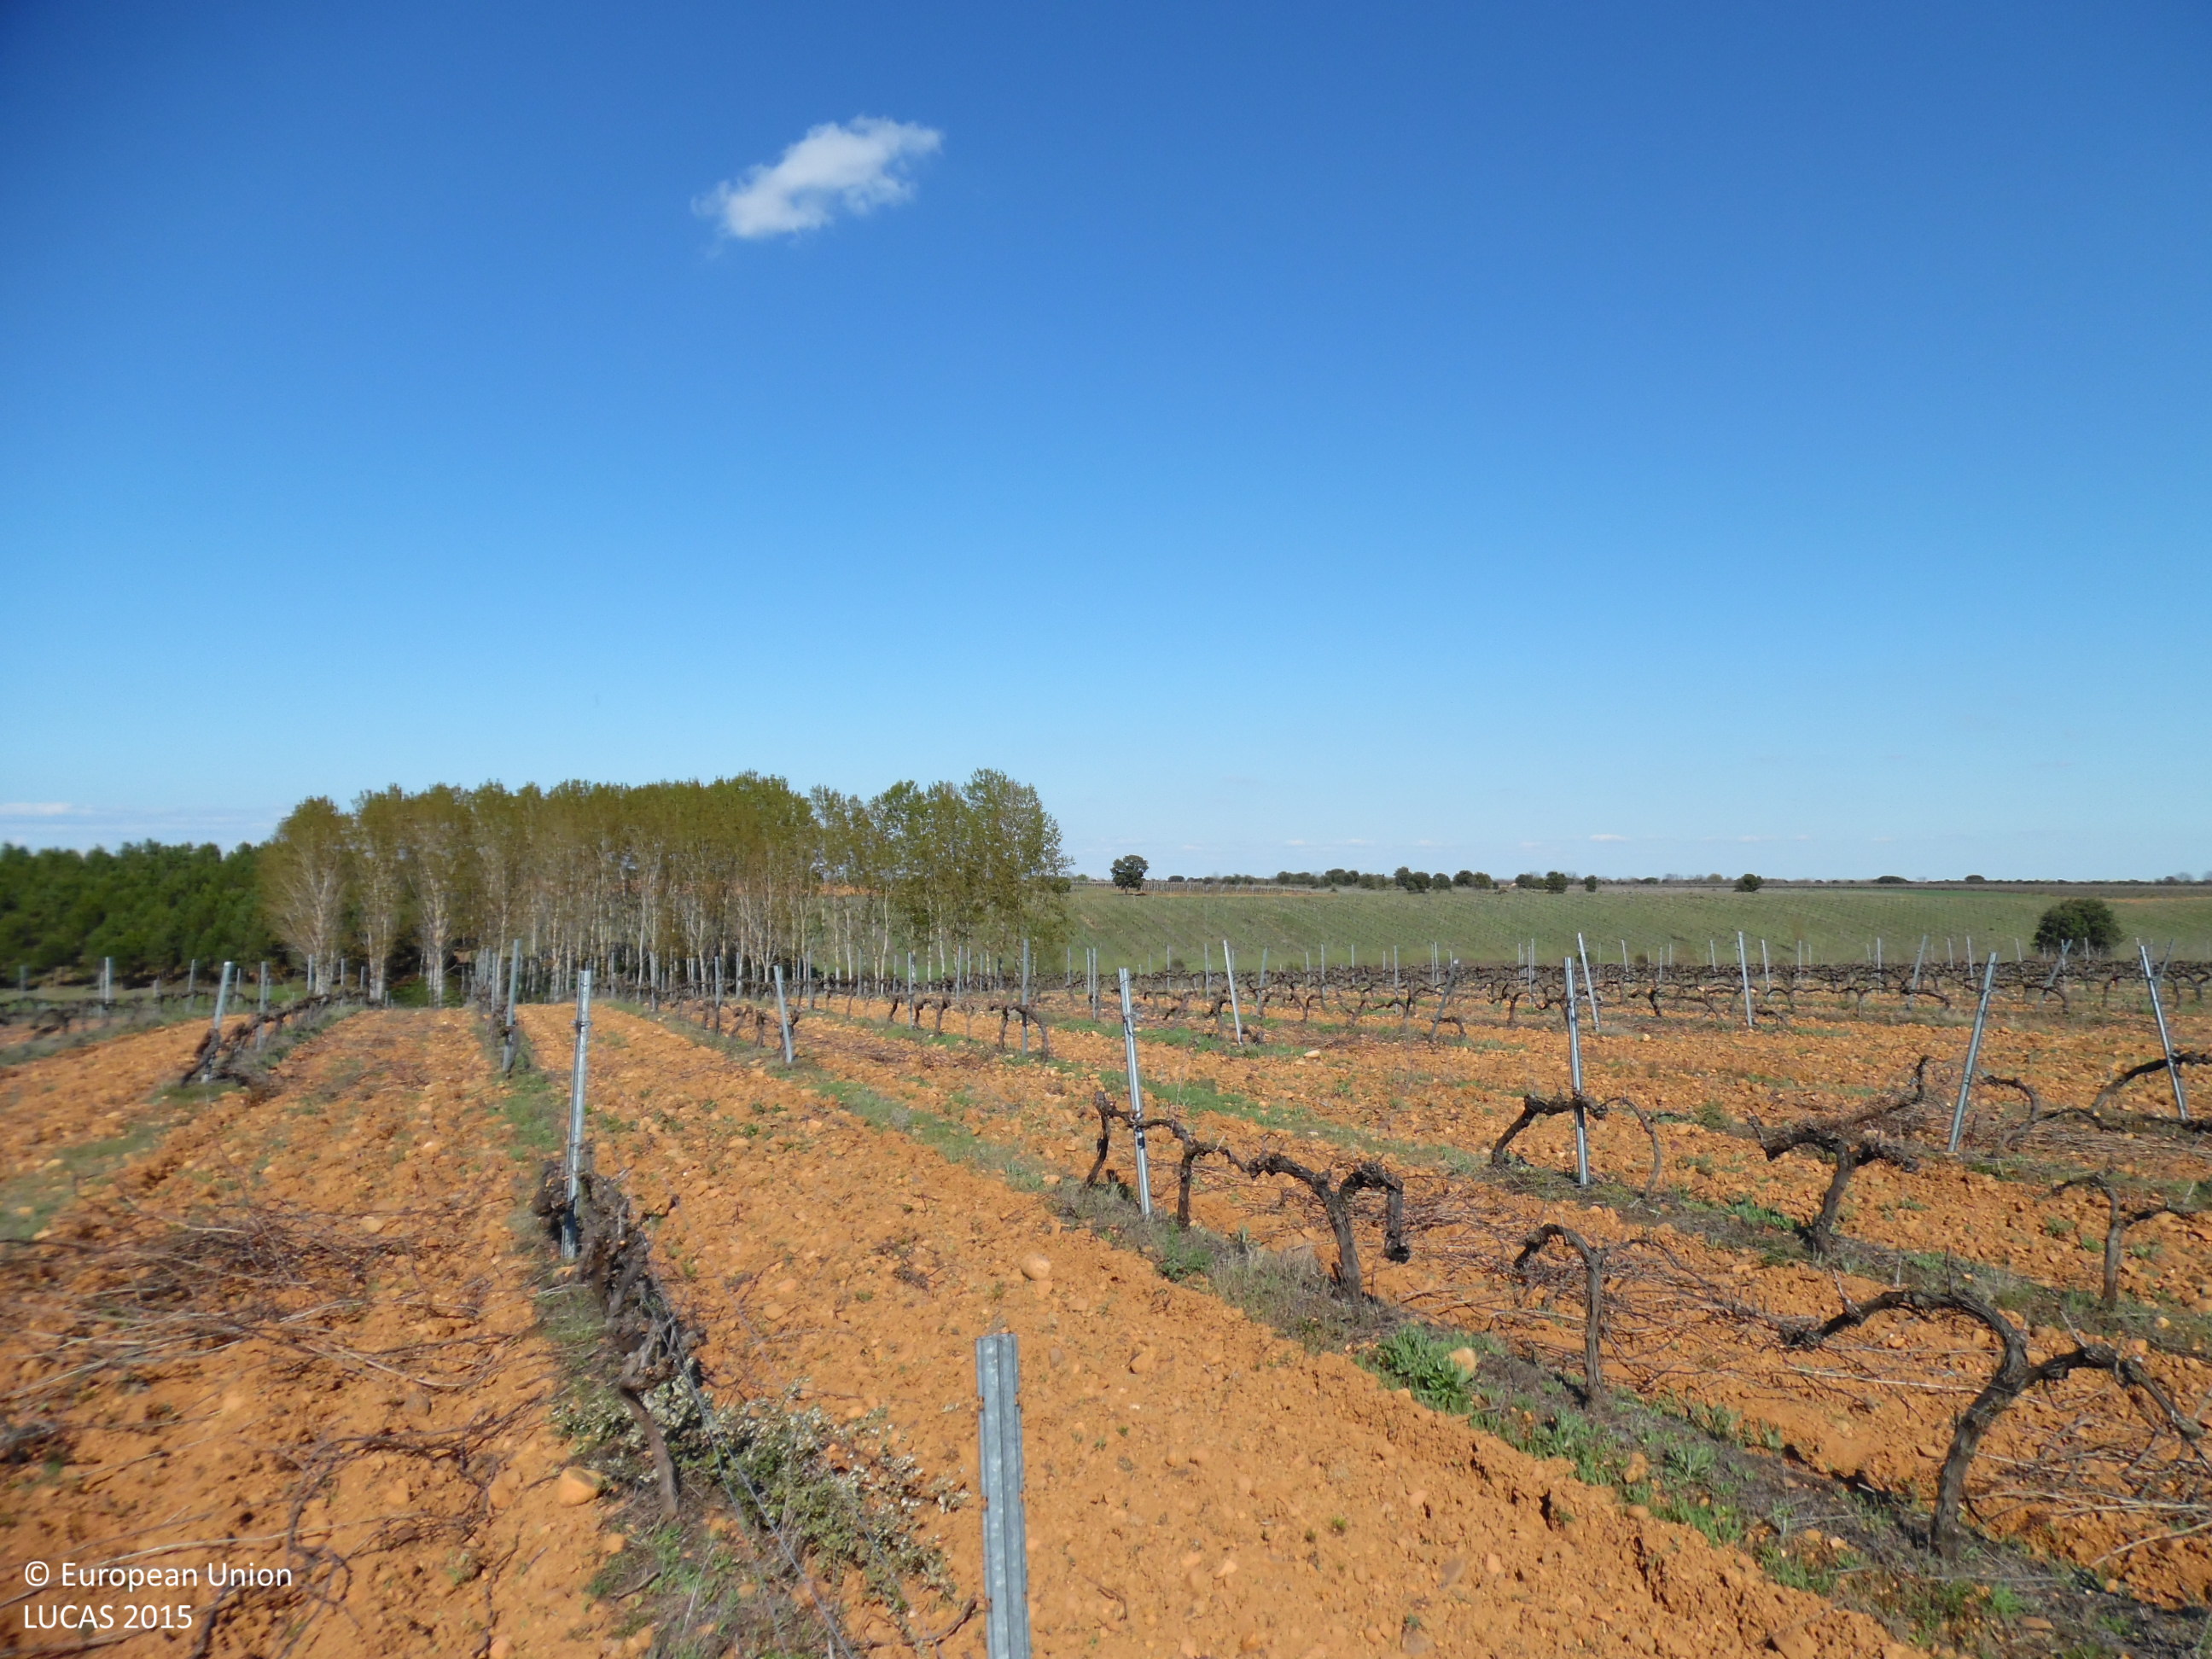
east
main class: Cropland
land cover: Vineyards
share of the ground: < 10 %
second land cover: Other bare soil
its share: > 75 %
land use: Agriculture (excluding fallow land and kitchen gardens)
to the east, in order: Vineyards; Other bare soil; Tracks; Vineyards; Other bare soil; Grass margins; Ditches and canals; Grass margins; Tracks; Grassland without tree/shrub cover; Rivers and streams; Shrubland without tree cover; Ditches and canals; Shruby margins; Grassland without tree/shrub cover; Vineyards
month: April
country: ES
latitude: 42.4884
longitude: -5.6831
